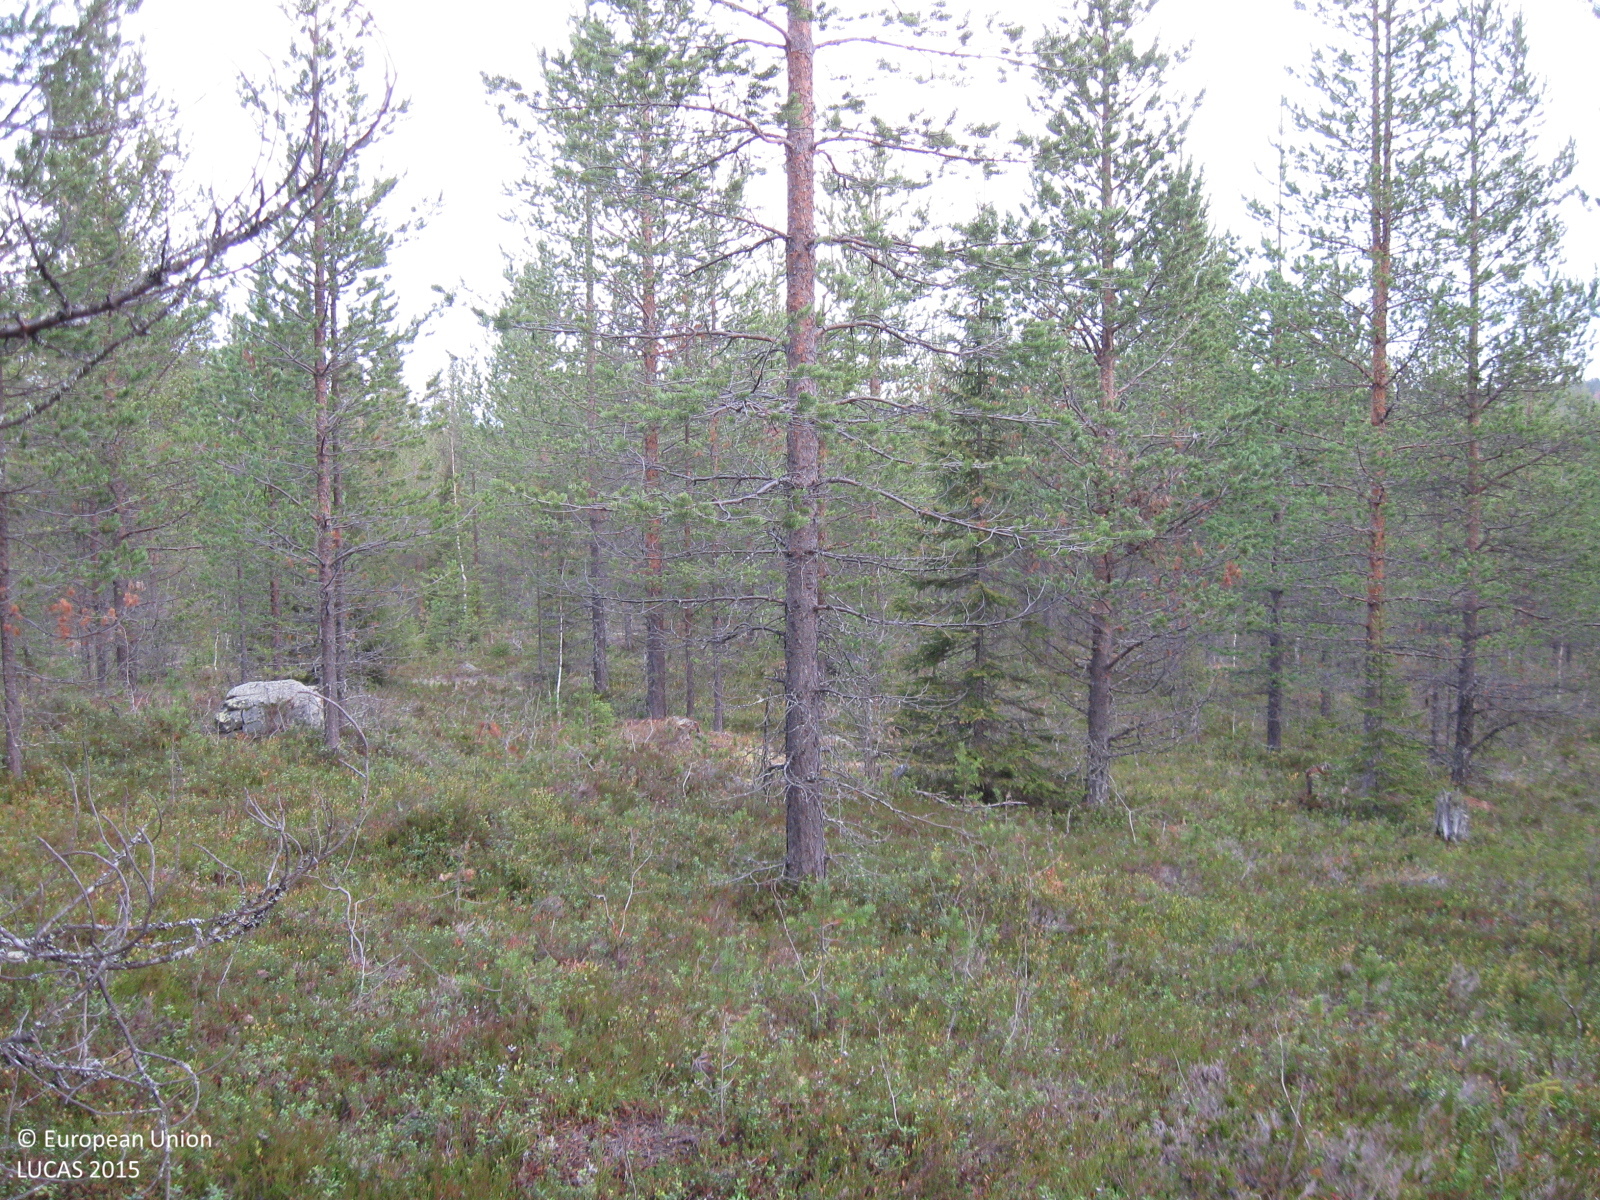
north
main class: Woodland
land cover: Pine dominated coniferous woodland
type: boreal forest
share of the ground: 50 - 75 %
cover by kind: coniferous forest trees 70 %, lichens and mosses 20 %, herbaceous plants 10 %
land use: Forestry
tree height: > 5 m
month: October
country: SE
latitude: 66.0861
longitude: 22.2442
